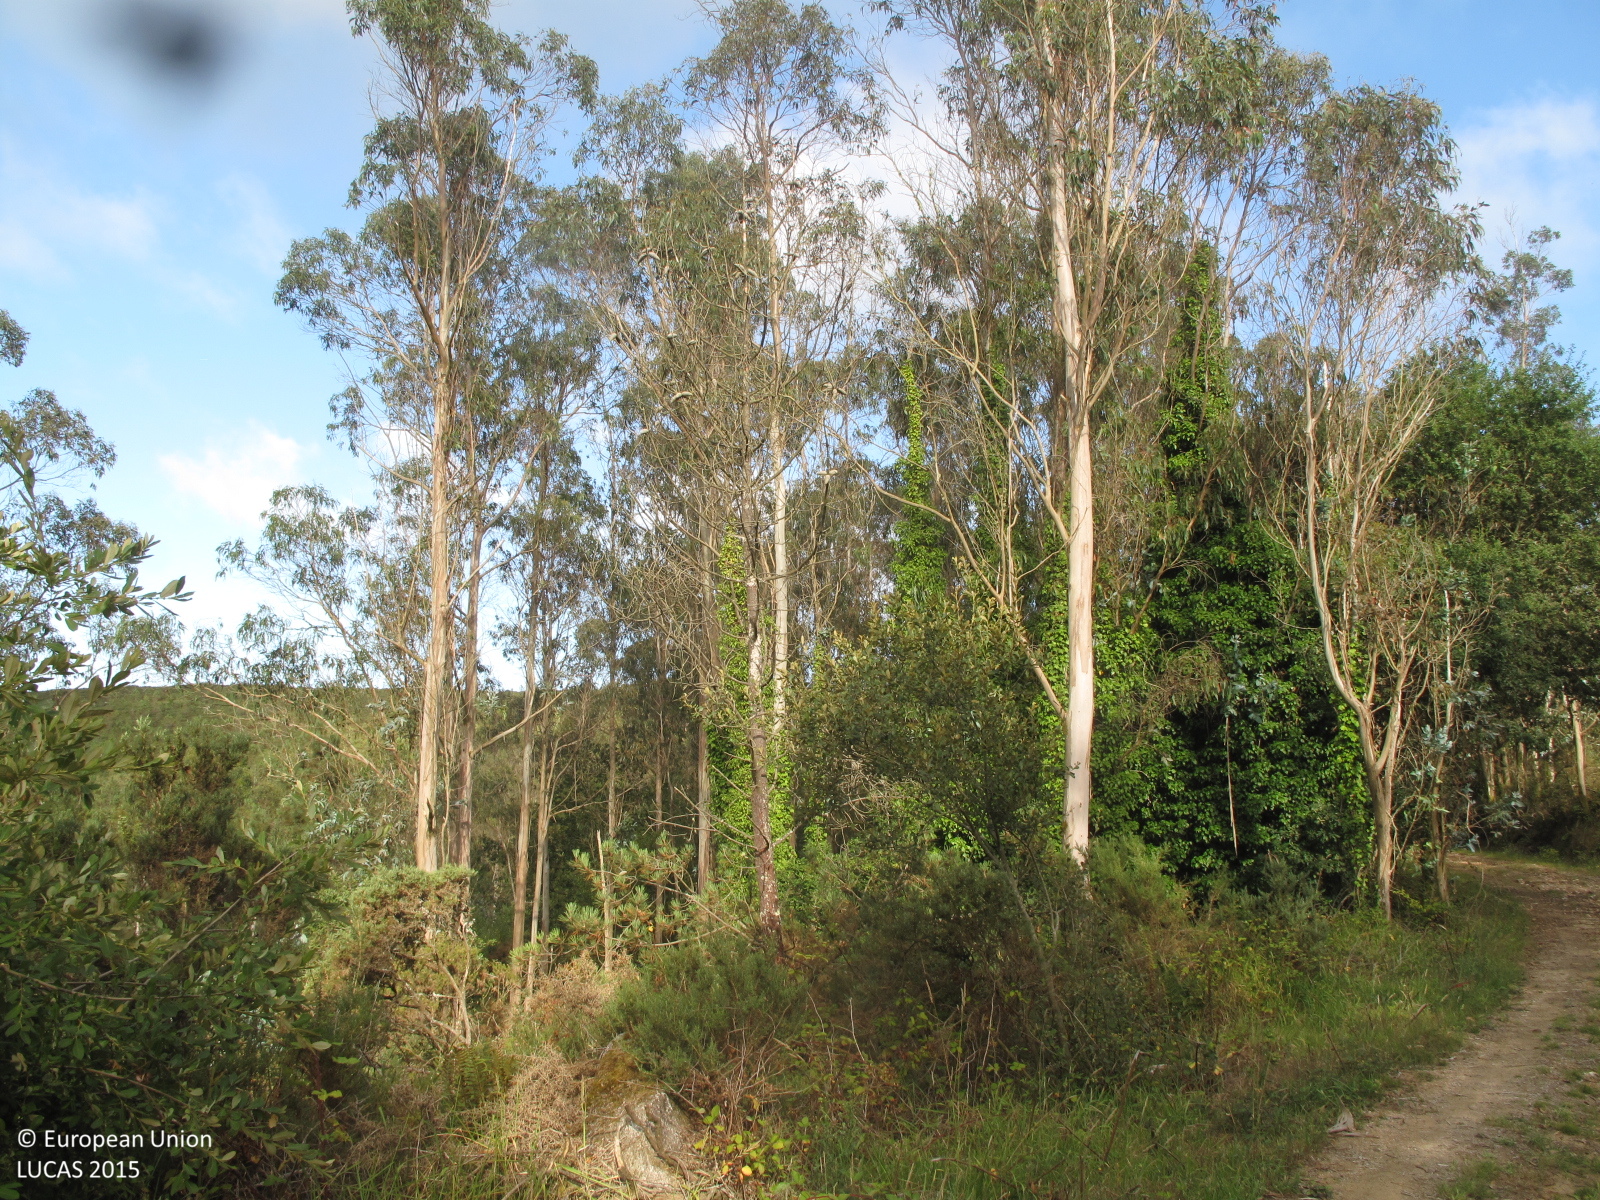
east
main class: Woodland
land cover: Pine dominated coniferous woodland
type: hemiboreal forest and nemoral coniferous forest and mixed broadleaved-coniferous forest
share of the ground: 50 - 75 %
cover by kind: coniferous forest trees 60 %, shrubs 20 %, herbaceous plants 20 %
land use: Forestry
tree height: > 5 m
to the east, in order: Pine dominated coniferous woodland; Tracks; Other mixed woodland; Shrubland with sparse tree cover; Rock outcrops; Shrubland with sparse tree cover
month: July
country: ES
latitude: 42.9602
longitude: -9.1133
